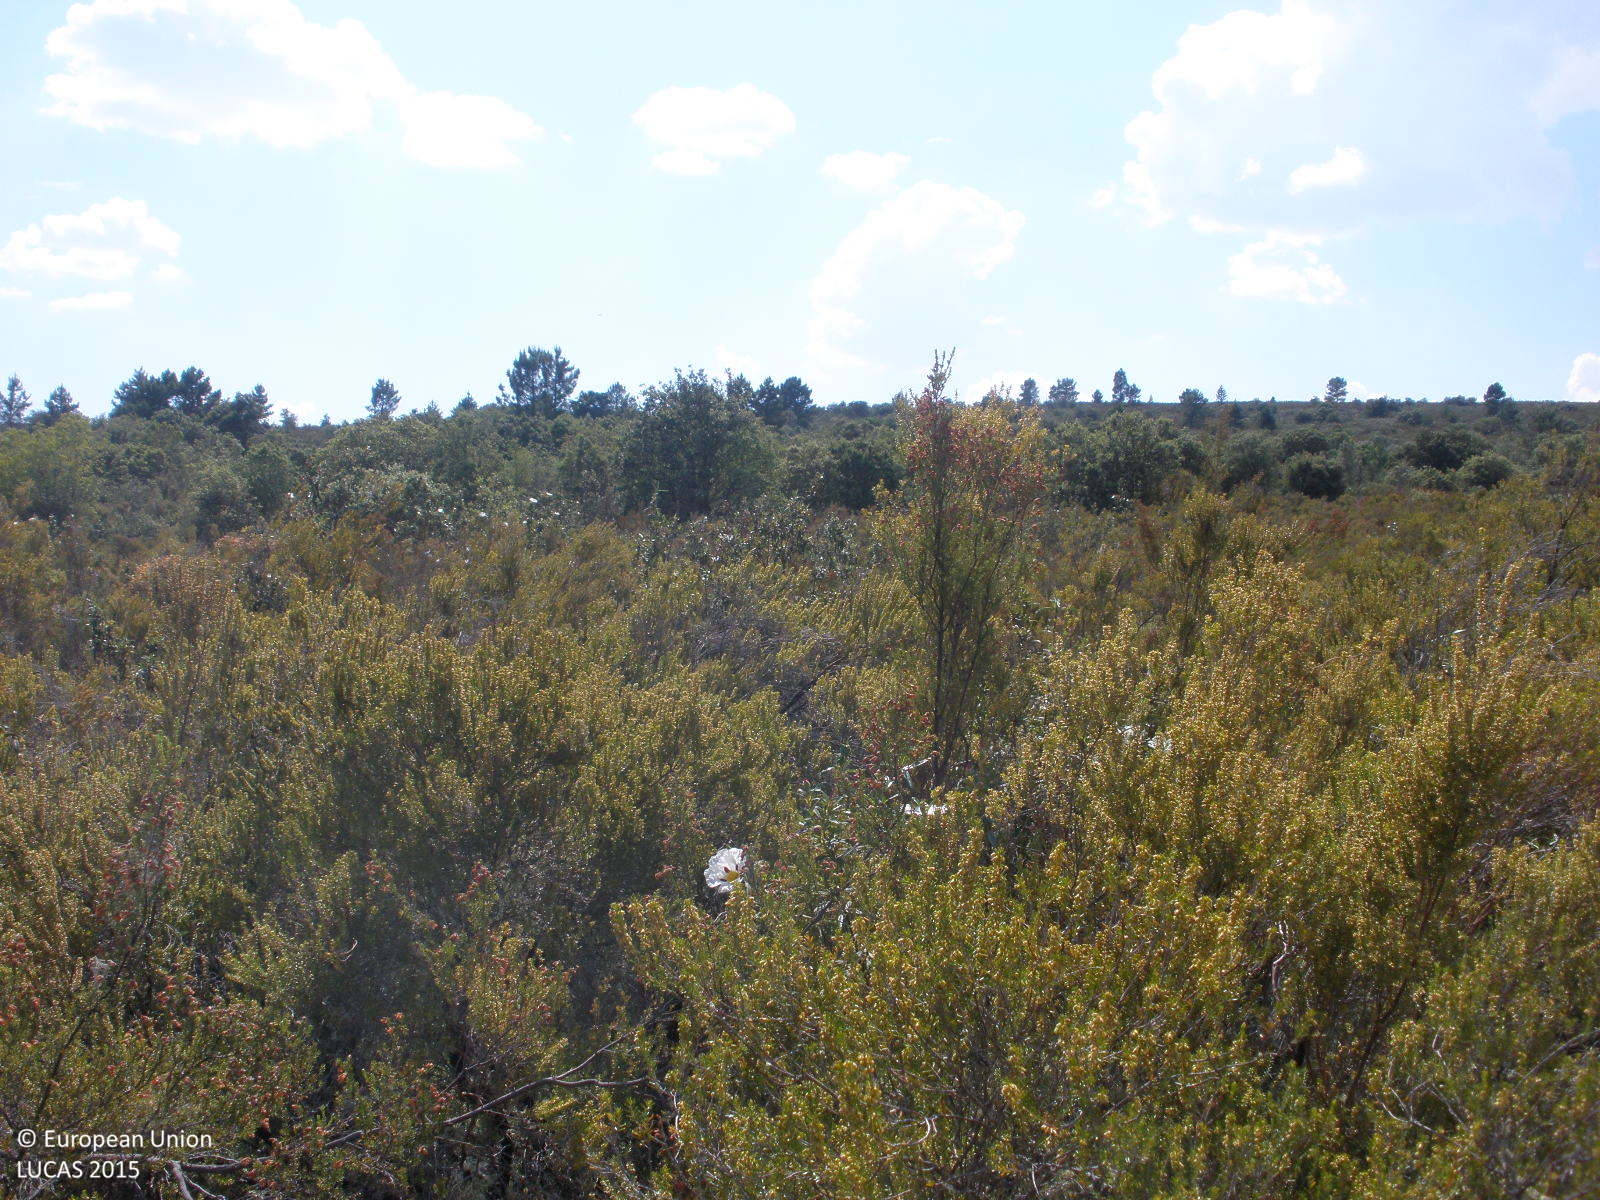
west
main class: Shrubland
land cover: Shrubland with sparse tree cover
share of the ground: > 75 %
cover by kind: shrubs 95 %, broadleaved forest trees 5 %
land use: Semi-natural and natural areas not in use
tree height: < 5 m
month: June
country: ES
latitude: 40.5433
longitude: -6.3436
